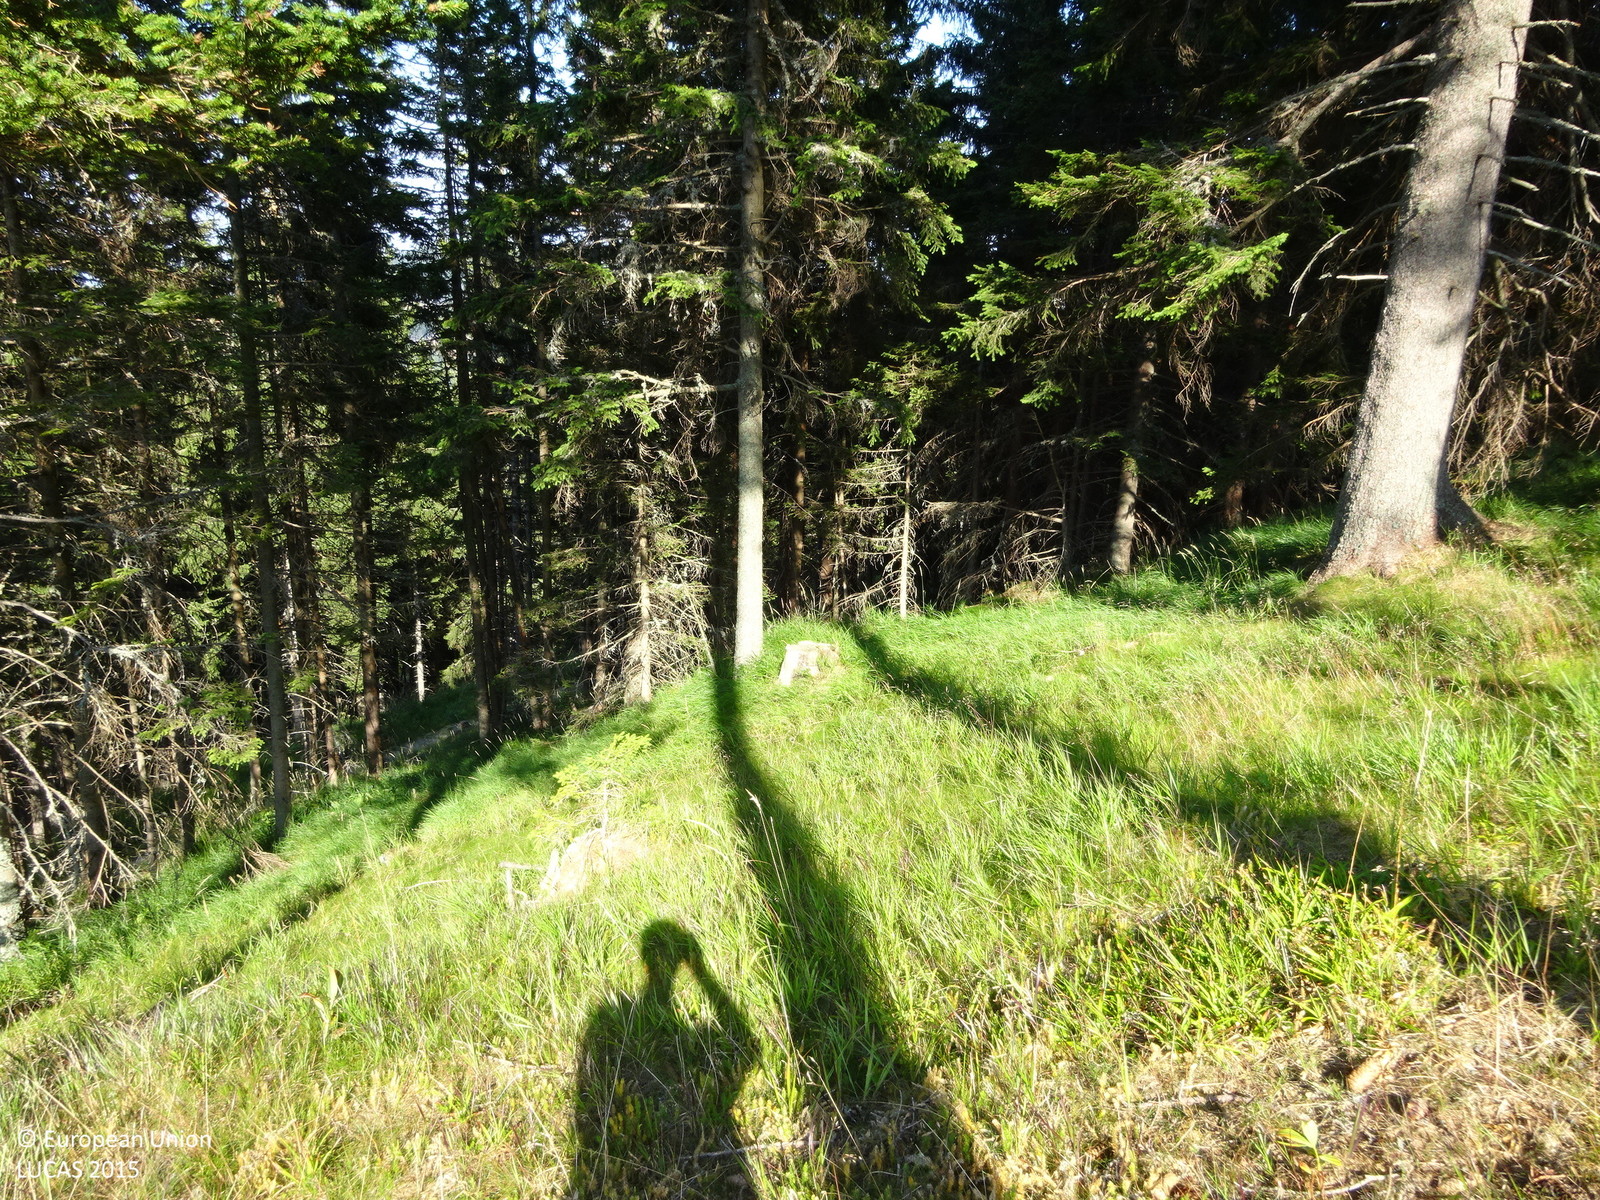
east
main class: Woodland
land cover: Spruce dominated coniferous woodland
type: alpine coniferous forest
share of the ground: > 75 %
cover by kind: coniferous forest trees 80 %, herbaceous plants 20 %
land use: Forestry
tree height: > 5 m
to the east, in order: Spruce dominated coniferous woodland; Grass margins; Tracks; Grass margins; Spruce dominated coniferous woodland
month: August
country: AT
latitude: 47.5192
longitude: 15.9915
